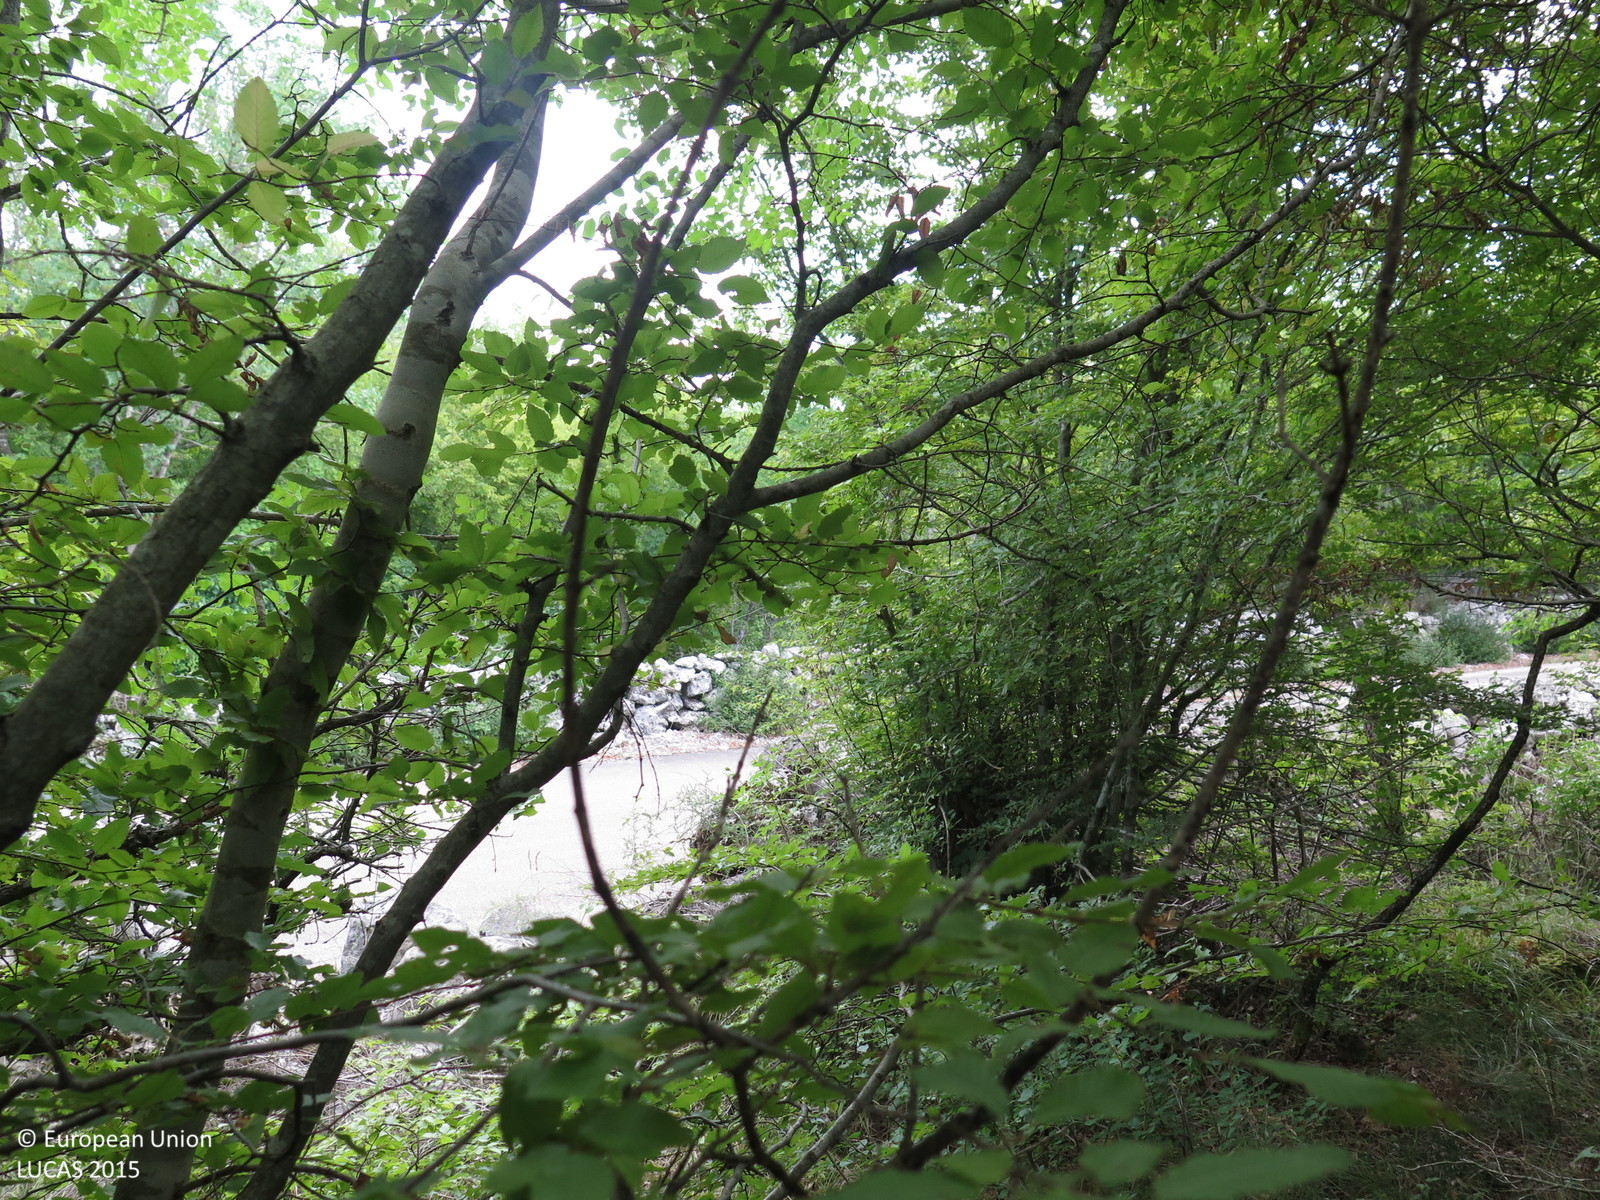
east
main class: Woodland
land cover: Broadleaved woodland
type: thermophilous deciduous forest
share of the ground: > 75 %
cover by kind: broadleaved forest trees 90 %, shrubs 5 %, herbaceous plants 5 %
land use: Semi-natural and natural areas not in use
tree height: < 5 m
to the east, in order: Broadleaved woodland; Dry stone walls; Paved roads, cycling and walking lanes; Dry stone walls; Broadleaved woodland; Temporary grasslands; Dry stone walls; Temporary grasslands; Broadleaved woodland; Olive groves; Tracks; Grassland with sparse tree/shrub cover; Tracks; Lines of trees; Dry stone walls; Lines of trees; Broadleaved woodland
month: August
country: HR
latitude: 45.0654
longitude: 14.5030
